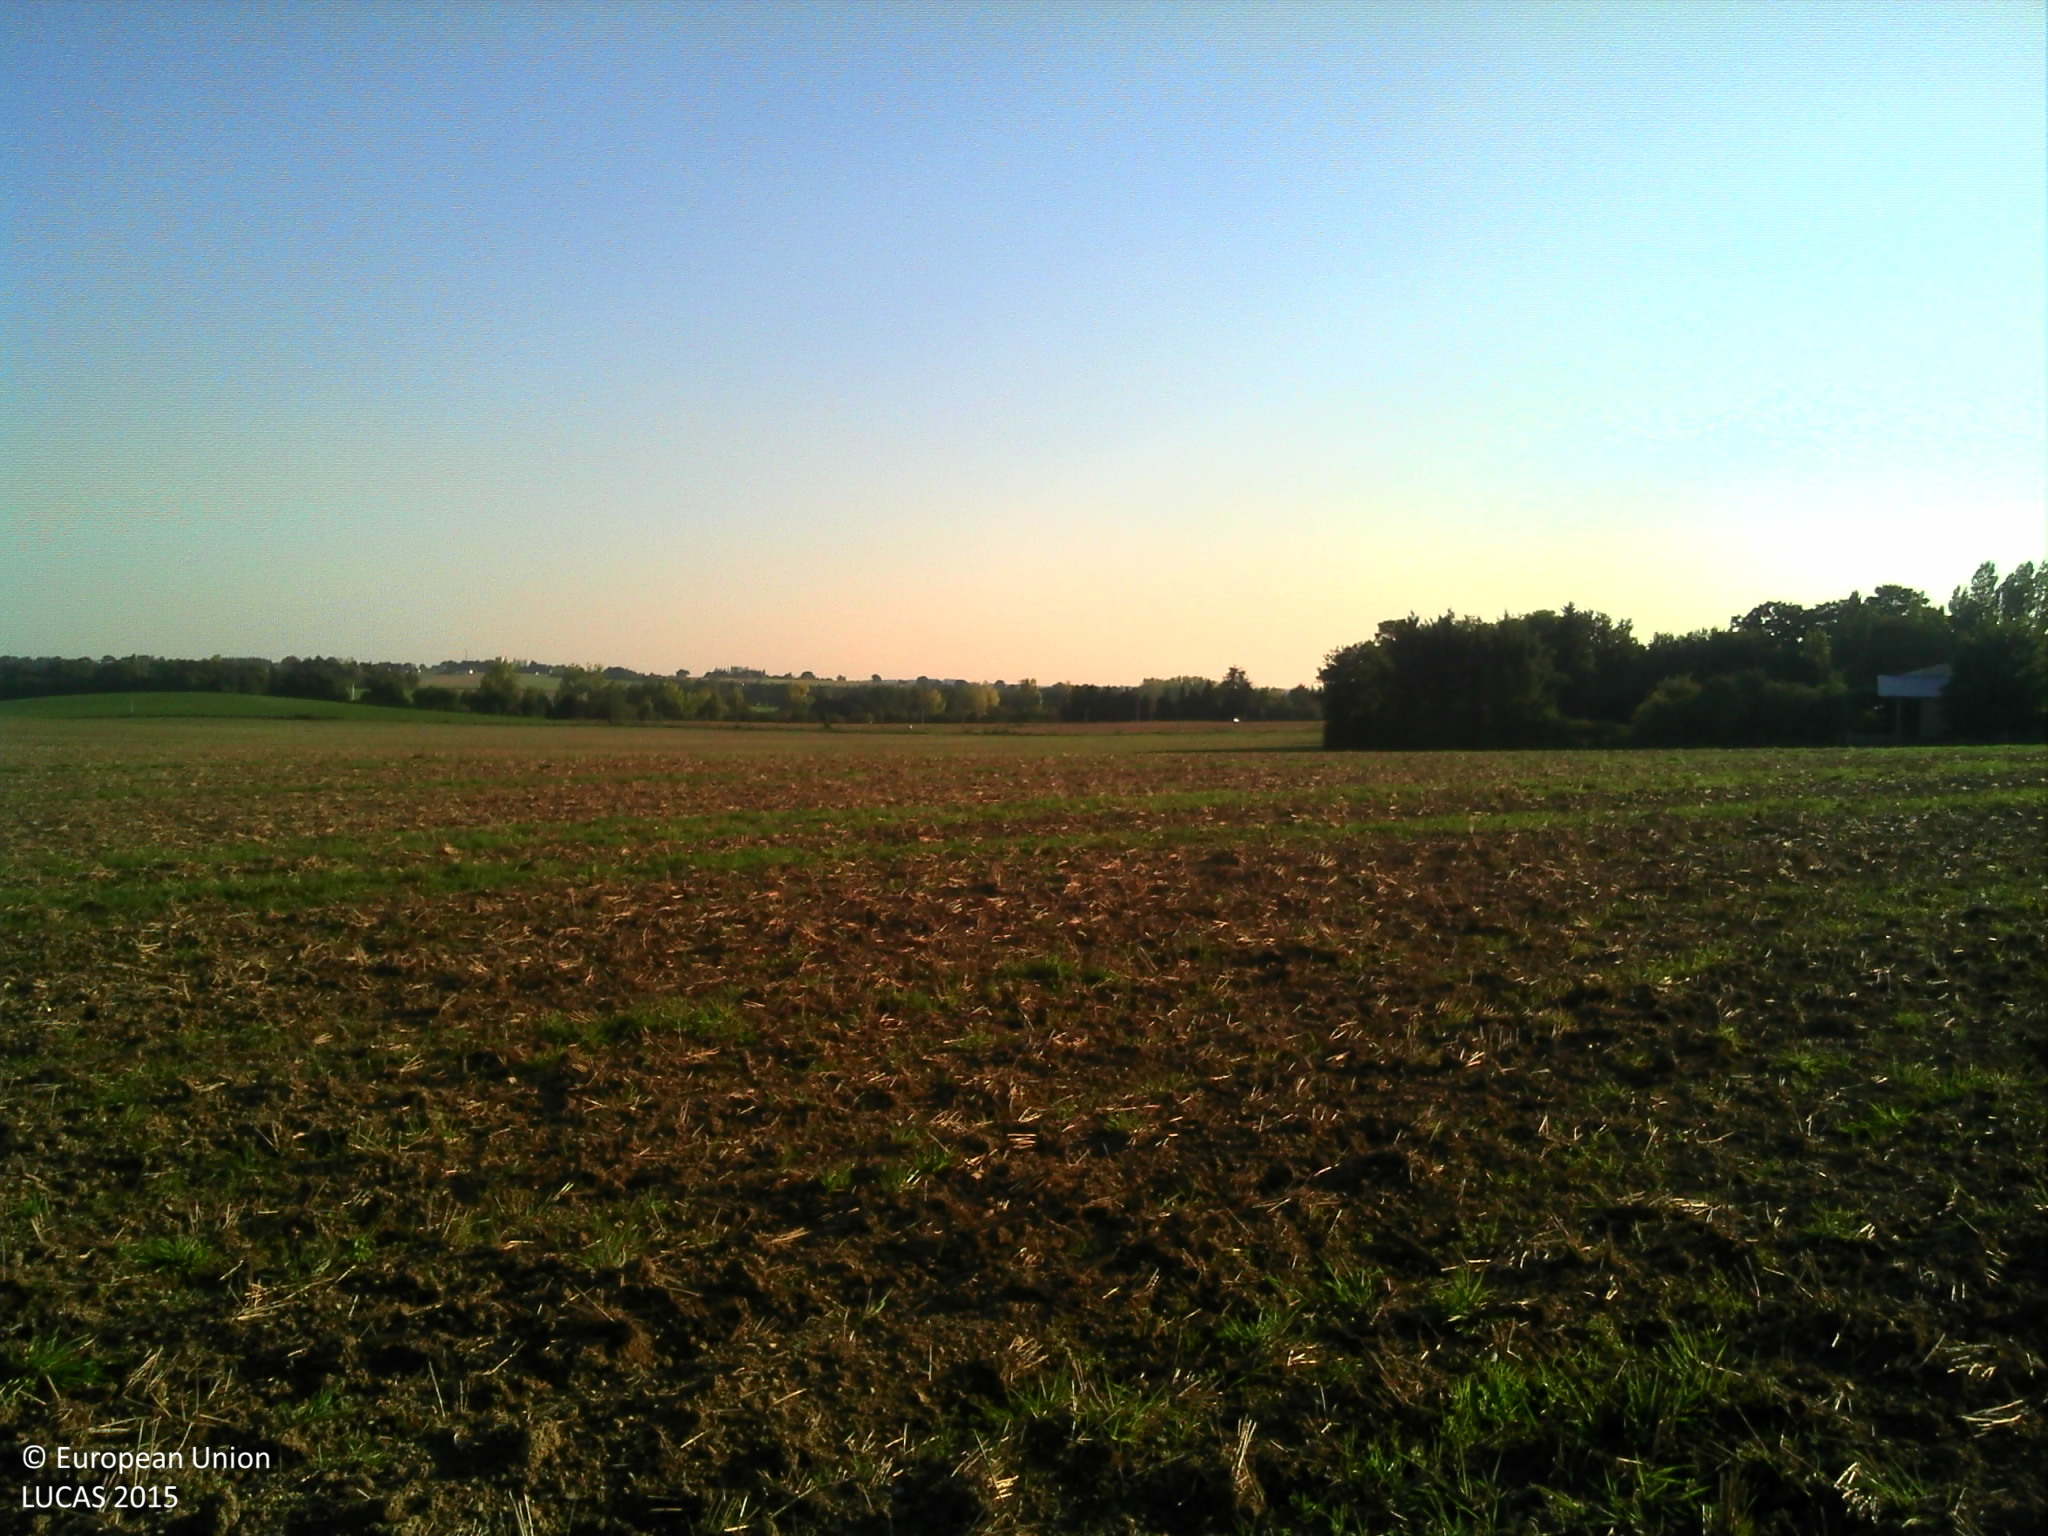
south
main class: Cropland
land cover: Common wheat
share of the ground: > 75 %
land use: Agriculture (excluding fallow land and kitchen gardens)
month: June
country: FR
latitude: 48.0473
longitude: -1.4065
